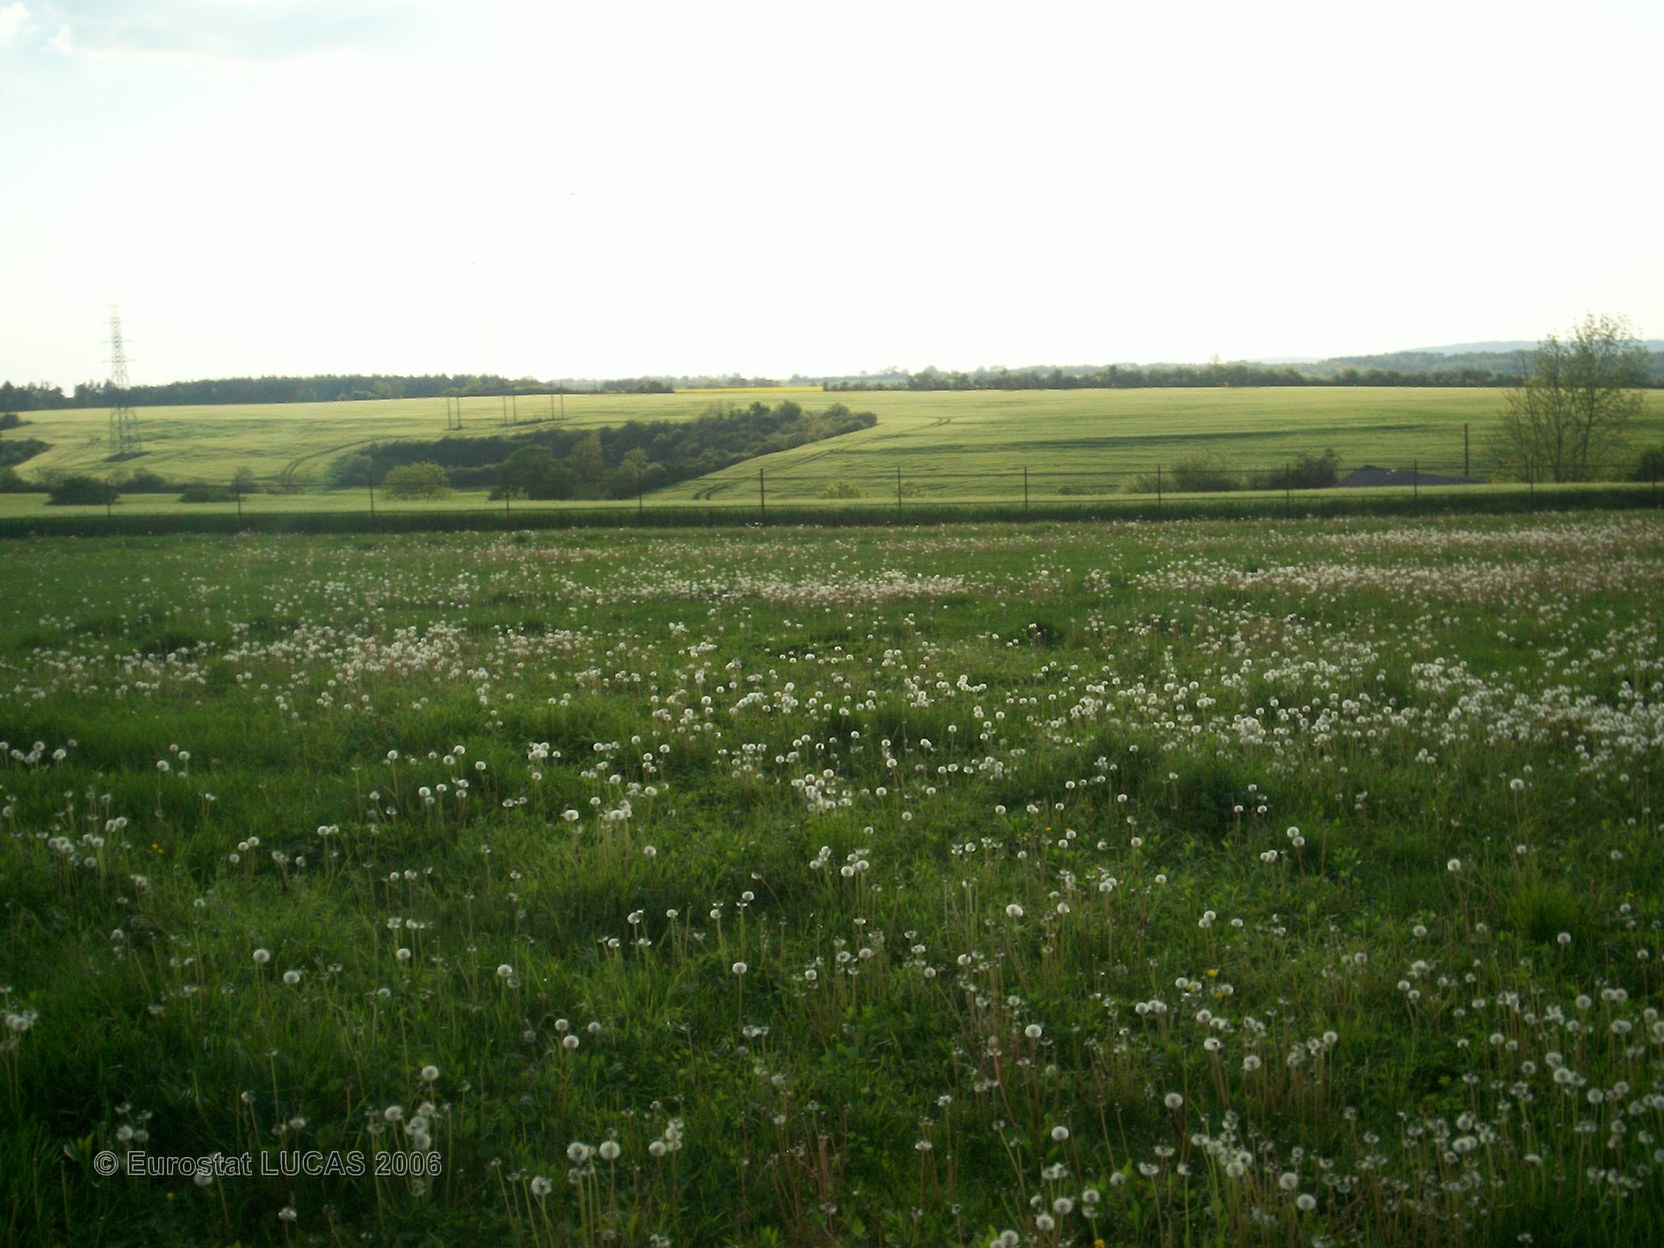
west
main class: Grassland
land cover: Grassland without tree/shrub cover
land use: Agriculture (excluding fallow land and kitchen gardens)
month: May
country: FR
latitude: 47.8547
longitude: 4.5588
